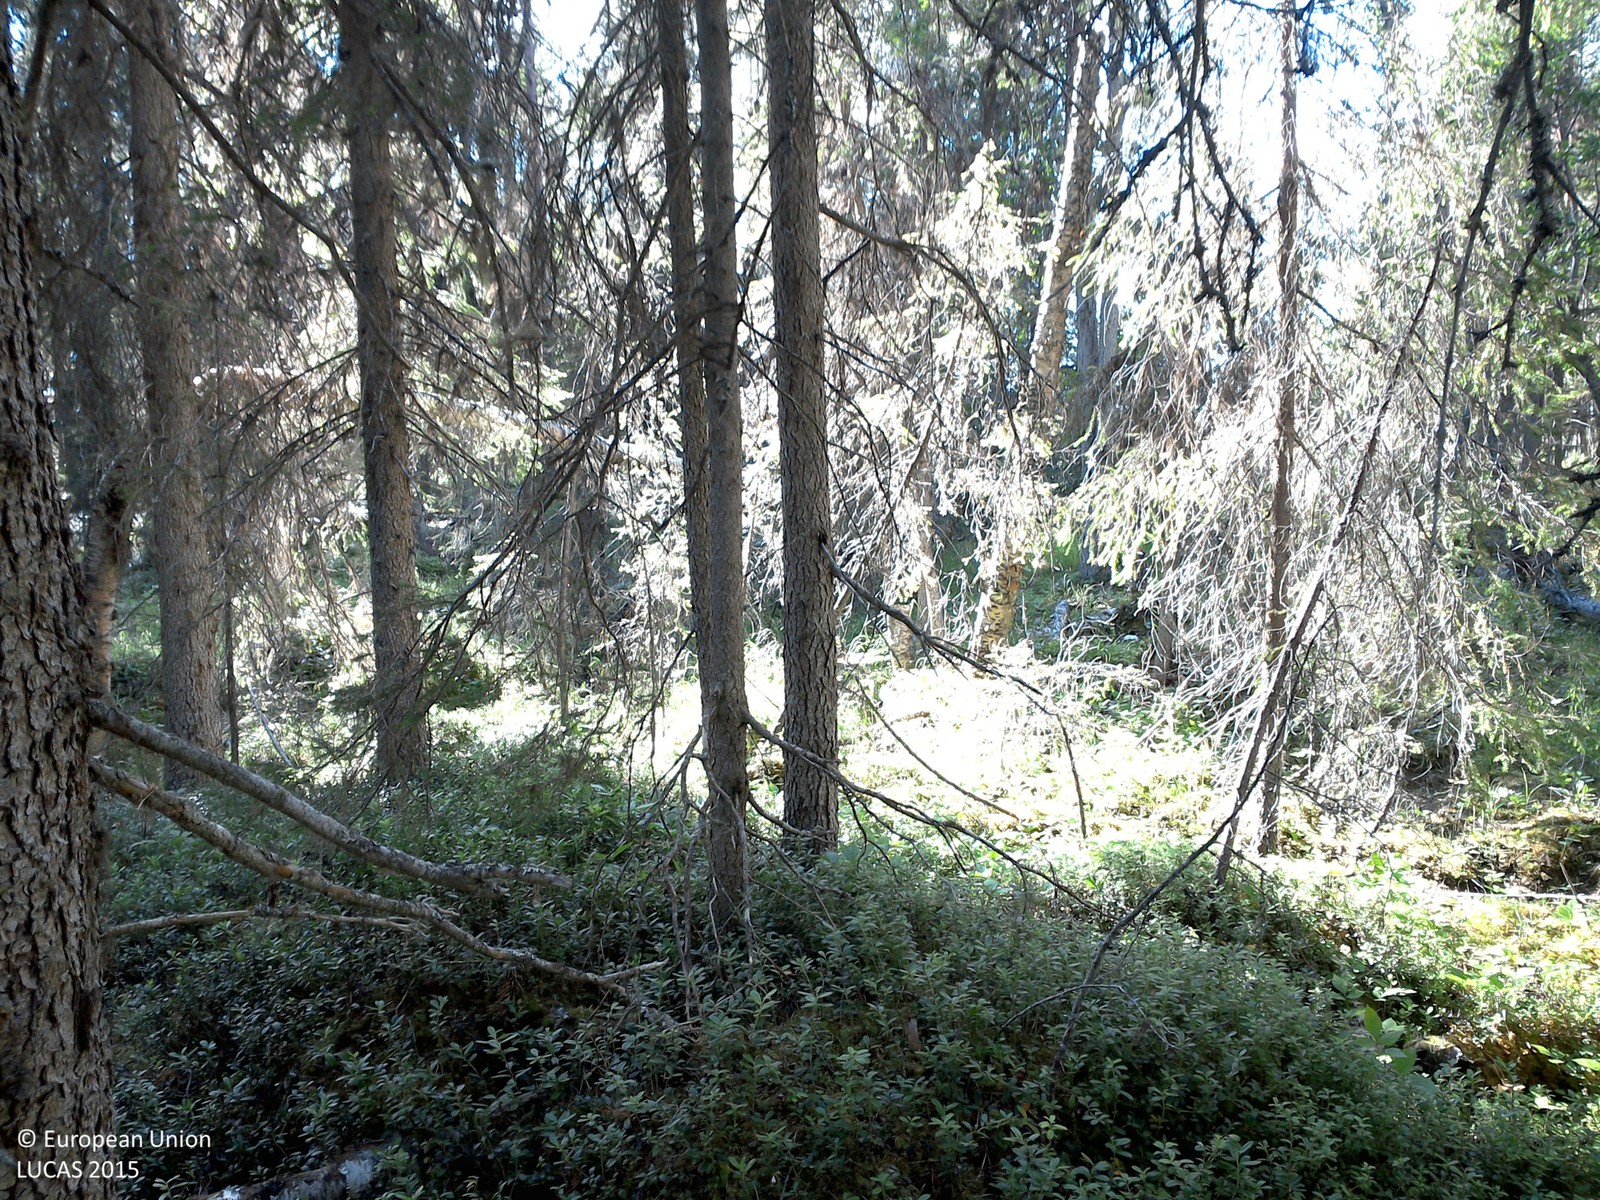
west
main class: Woodland
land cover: Spruce dominated coniferous woodland
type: boreal forest
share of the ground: 25 - 50 %
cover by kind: shrubs 55 %, coniferous forest trees 40 %, lichens and mosses 5 %
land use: Forestry
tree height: > 5 m
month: August
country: SE
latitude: 67.7432
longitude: 21.0872
